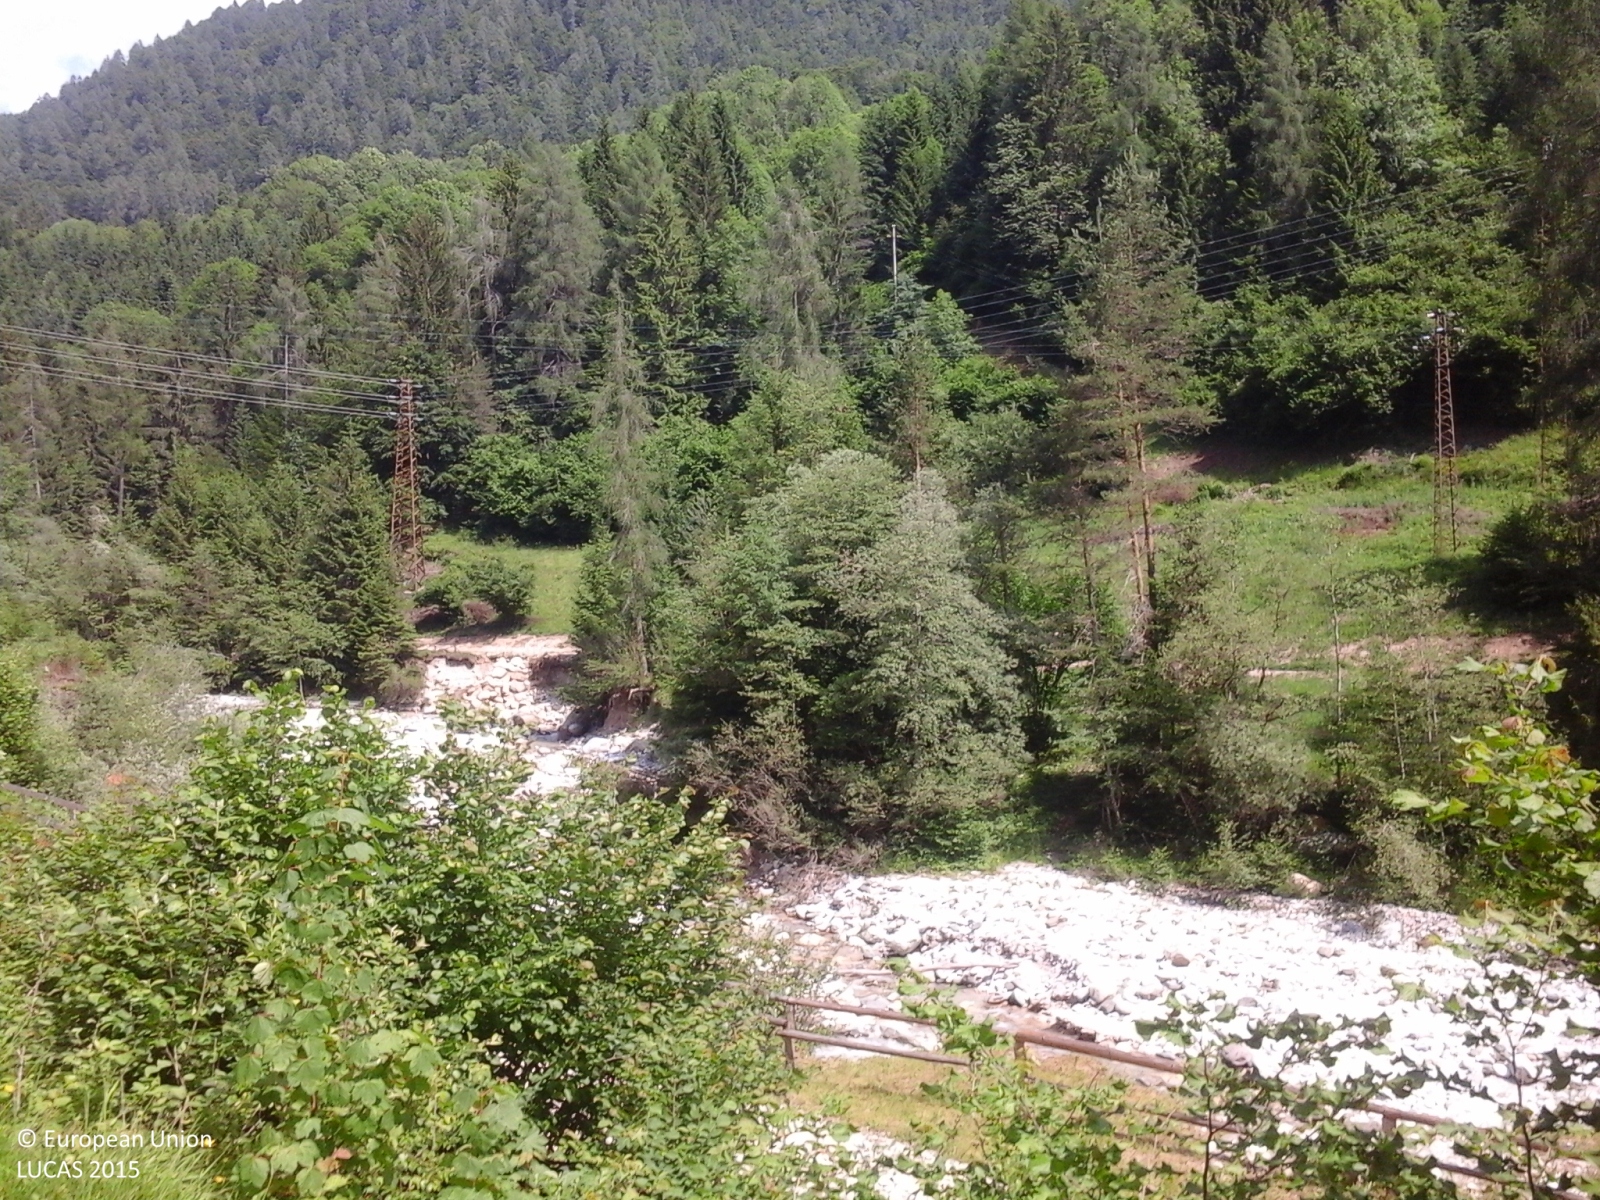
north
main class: Woodland
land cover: Spruce dominated mixed woodland
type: alpine coniferous forest
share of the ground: > 75 %
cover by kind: coniferous forest trees 75 %, broadleaved forest trees 25 %
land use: Semi-natural and natural areas not in use
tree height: > 5 m
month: June
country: IT
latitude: 46.4509
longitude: 12.3797
